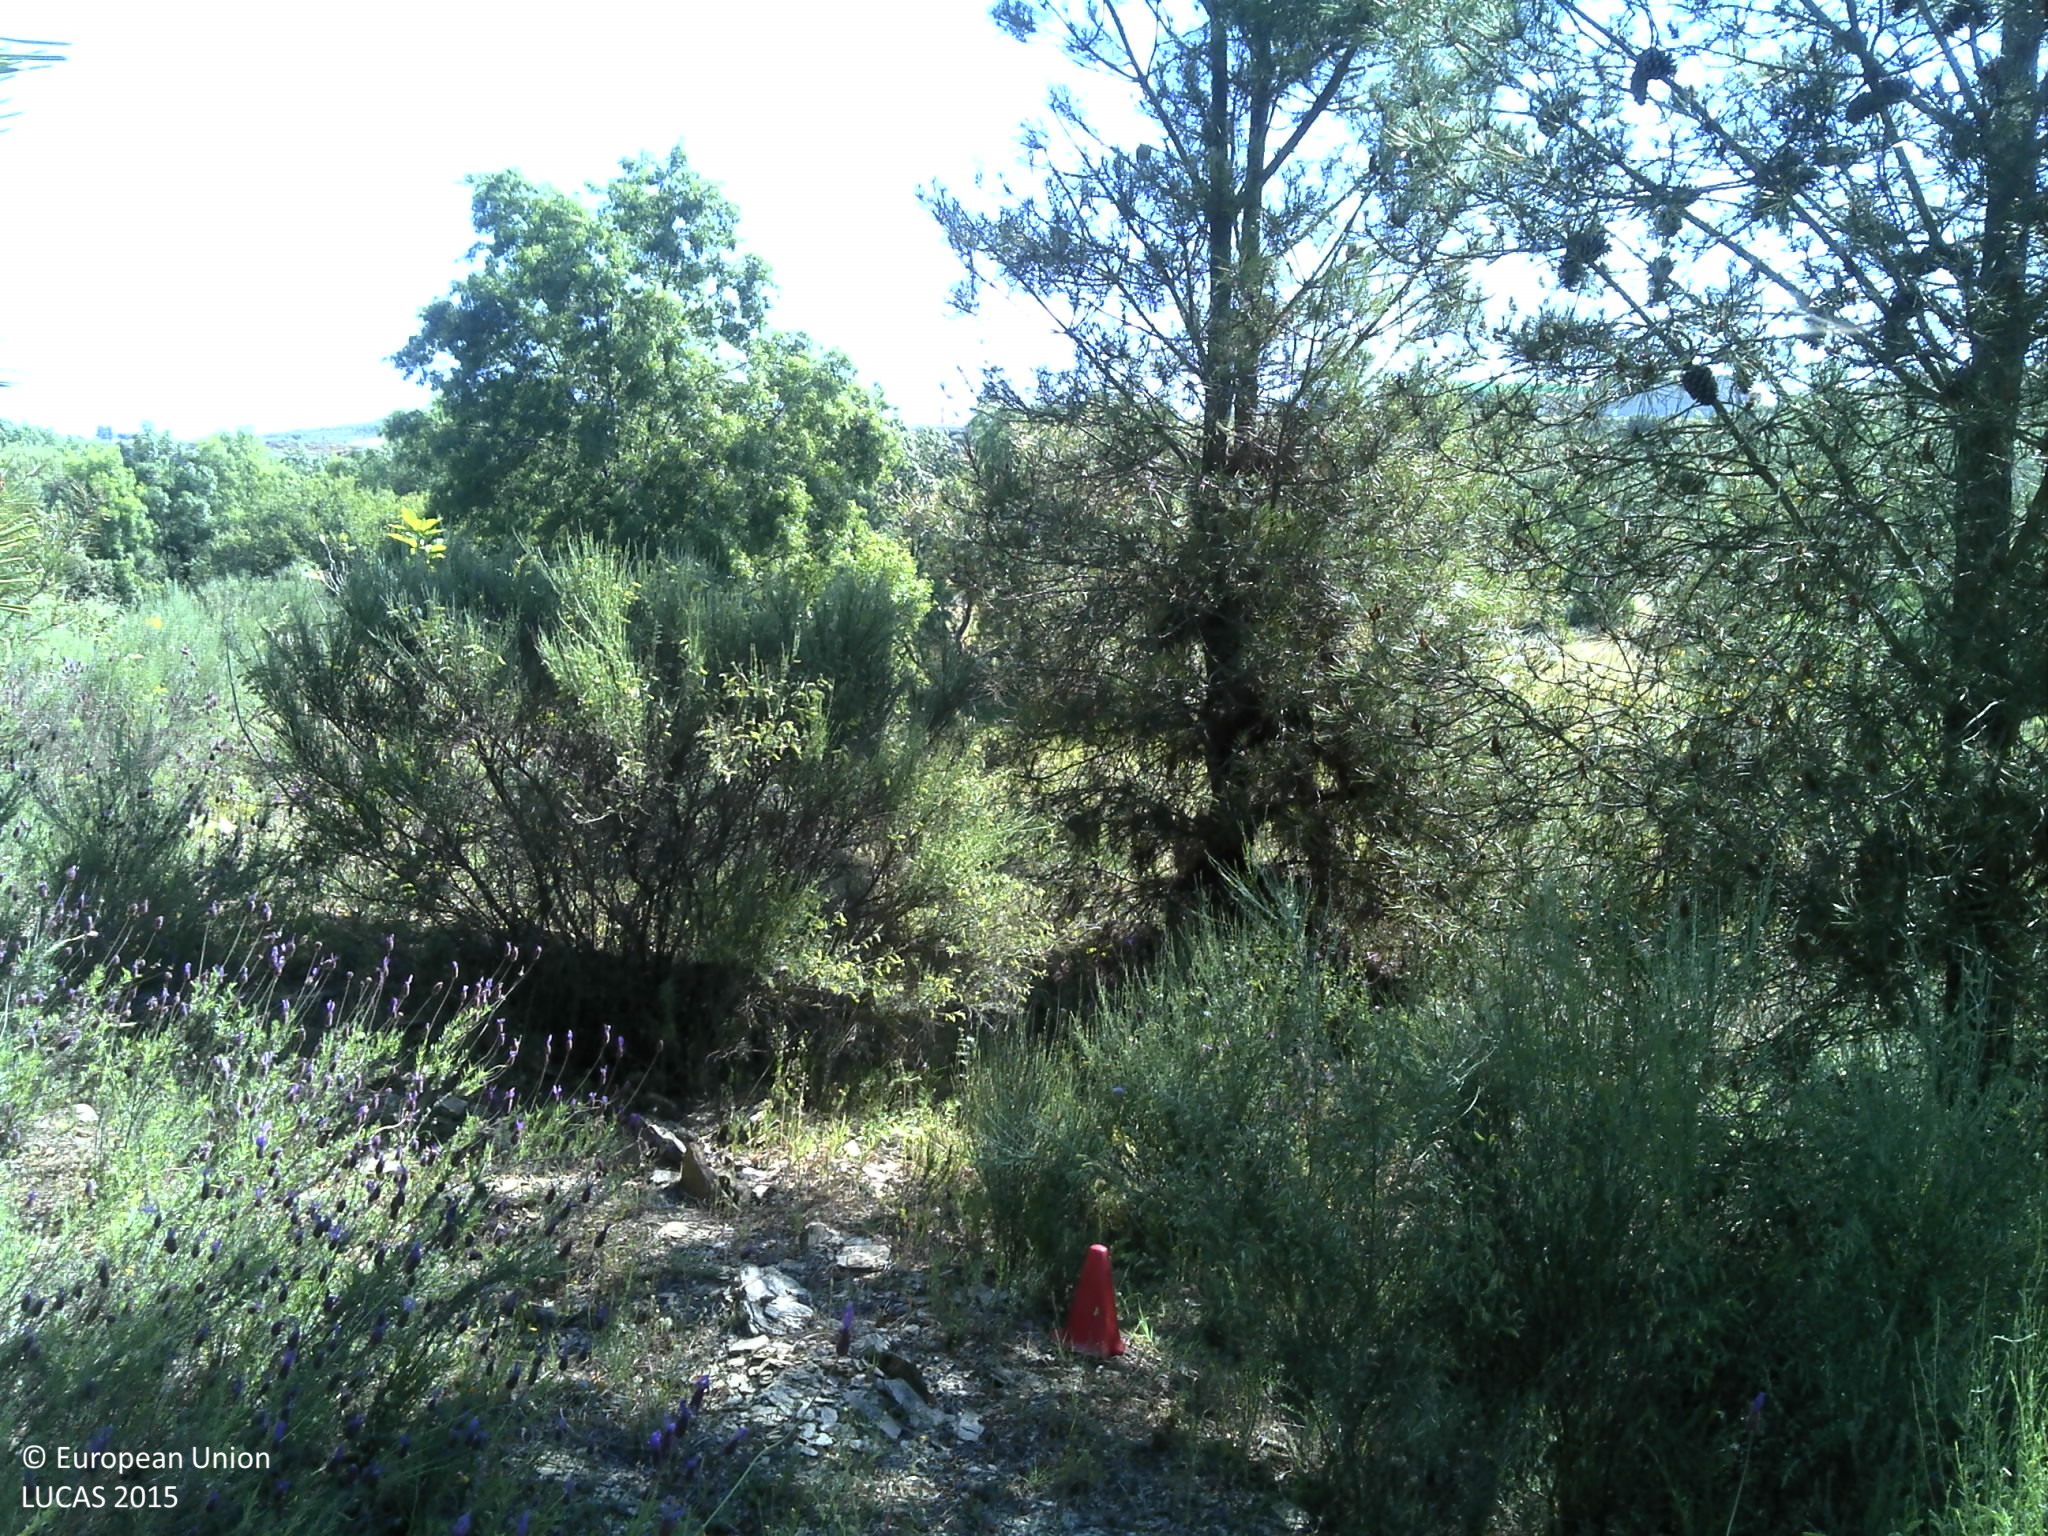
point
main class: Woodland
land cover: Pine dominated coniferous woodland
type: coniferous forest of the mediterranean region
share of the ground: 10 - 25 %
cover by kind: coniferous forest trees 20 %, shrubs 20 %, herbaceous plants 10 %, unconsolidated bare surface 10 %
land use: Forestry
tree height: > 5 m
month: May
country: PT
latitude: 41.5585
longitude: -6.5432
